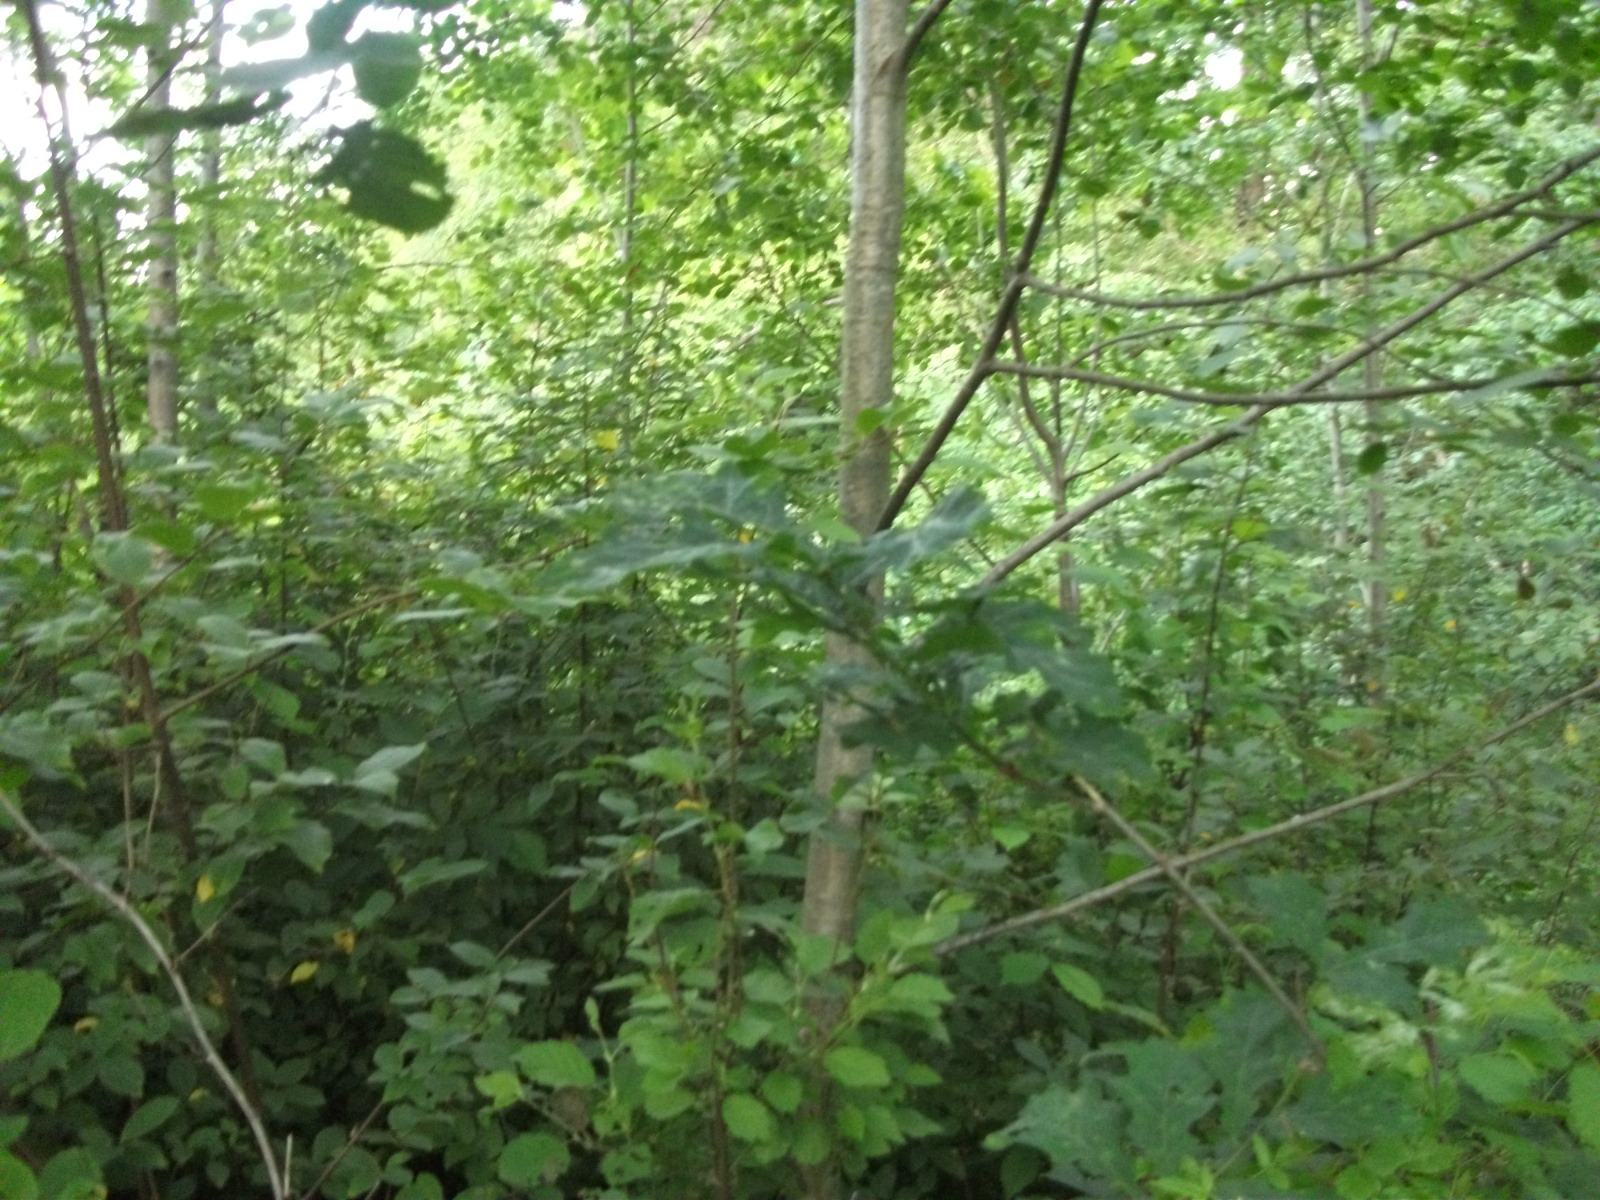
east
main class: Woodland
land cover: Broadleaved woodland
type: non-riverine alder, birch or aspen forest
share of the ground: > 75 %
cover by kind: broadleaved forest trees 90 %, shrubs 5 %, herbaceous plants 5 %
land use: Forestry
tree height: > 5 m
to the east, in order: Broadleaved woodland; Ditches and canals; Shruby margins; Spontaneously vegetated surfaces
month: June
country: LV
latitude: 56.9362
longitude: 26.5997
